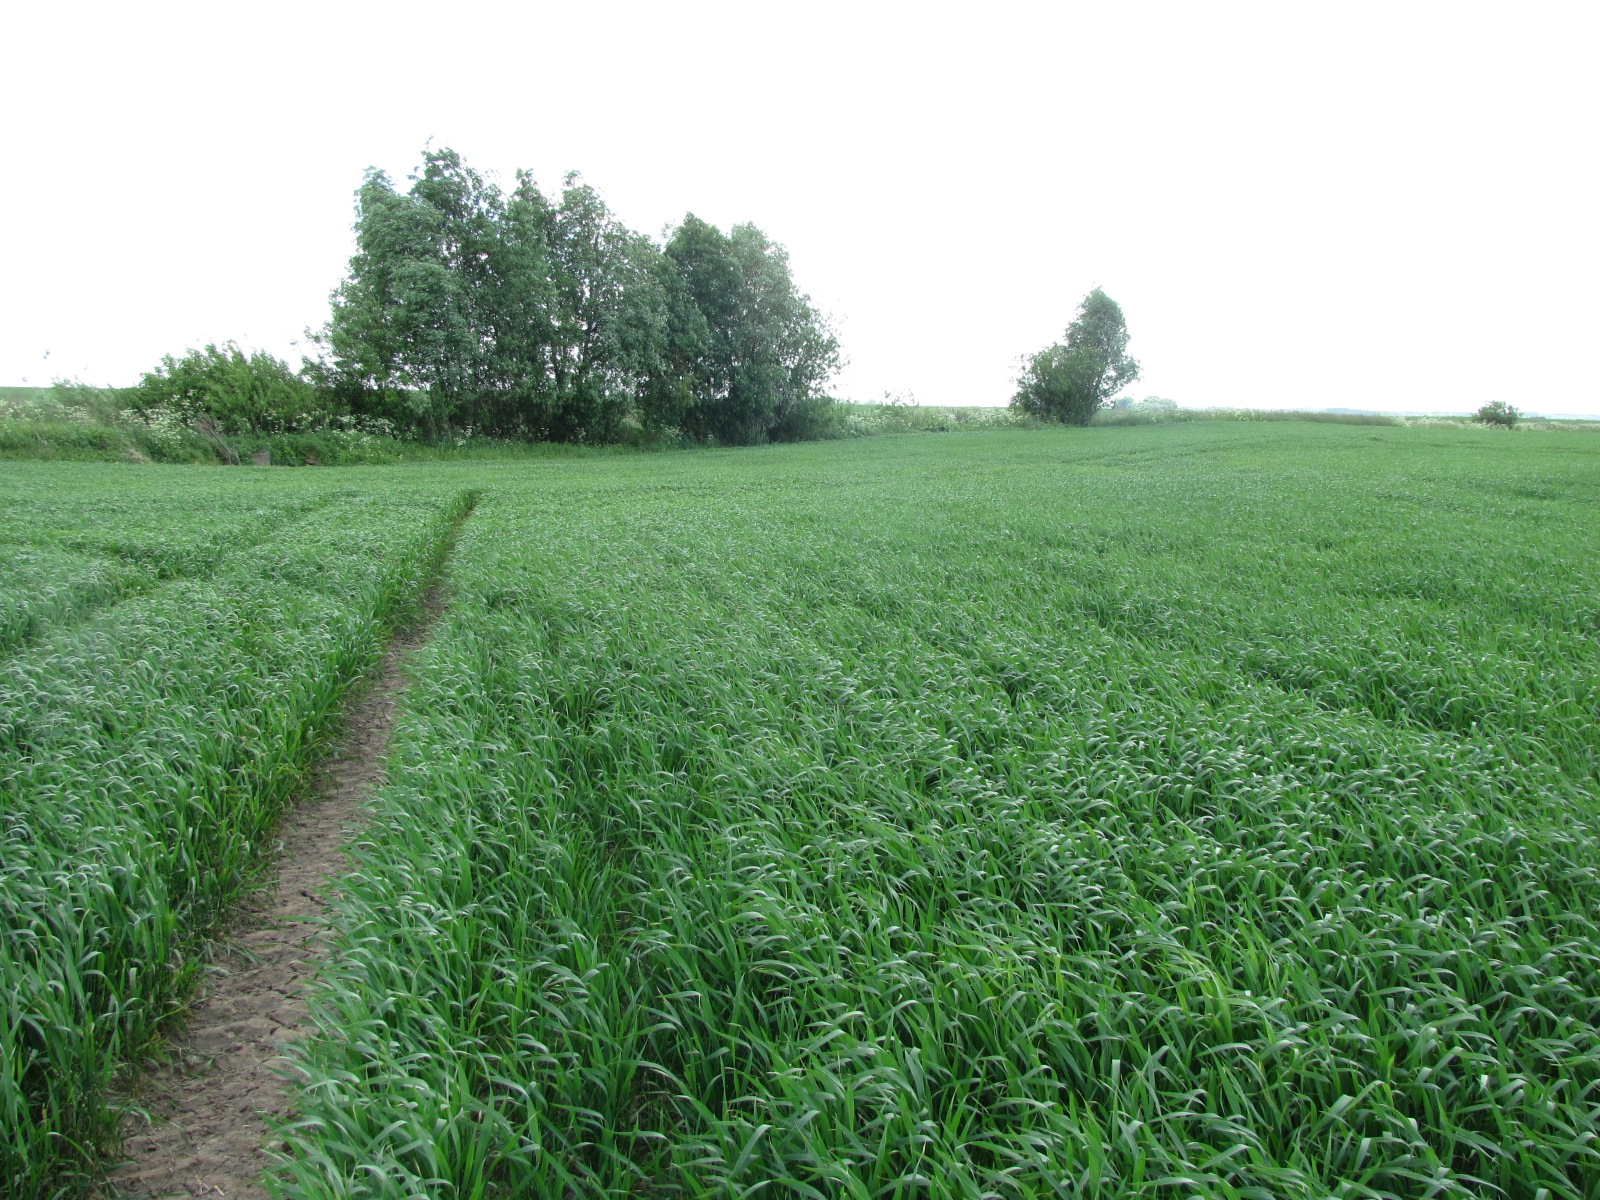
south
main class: Cropland
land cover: Common wheat
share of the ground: > 75 %
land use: Agriculture (excluding fallow land and kitchen gardens)
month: June
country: LV
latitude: 56.2542
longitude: 24.1811
